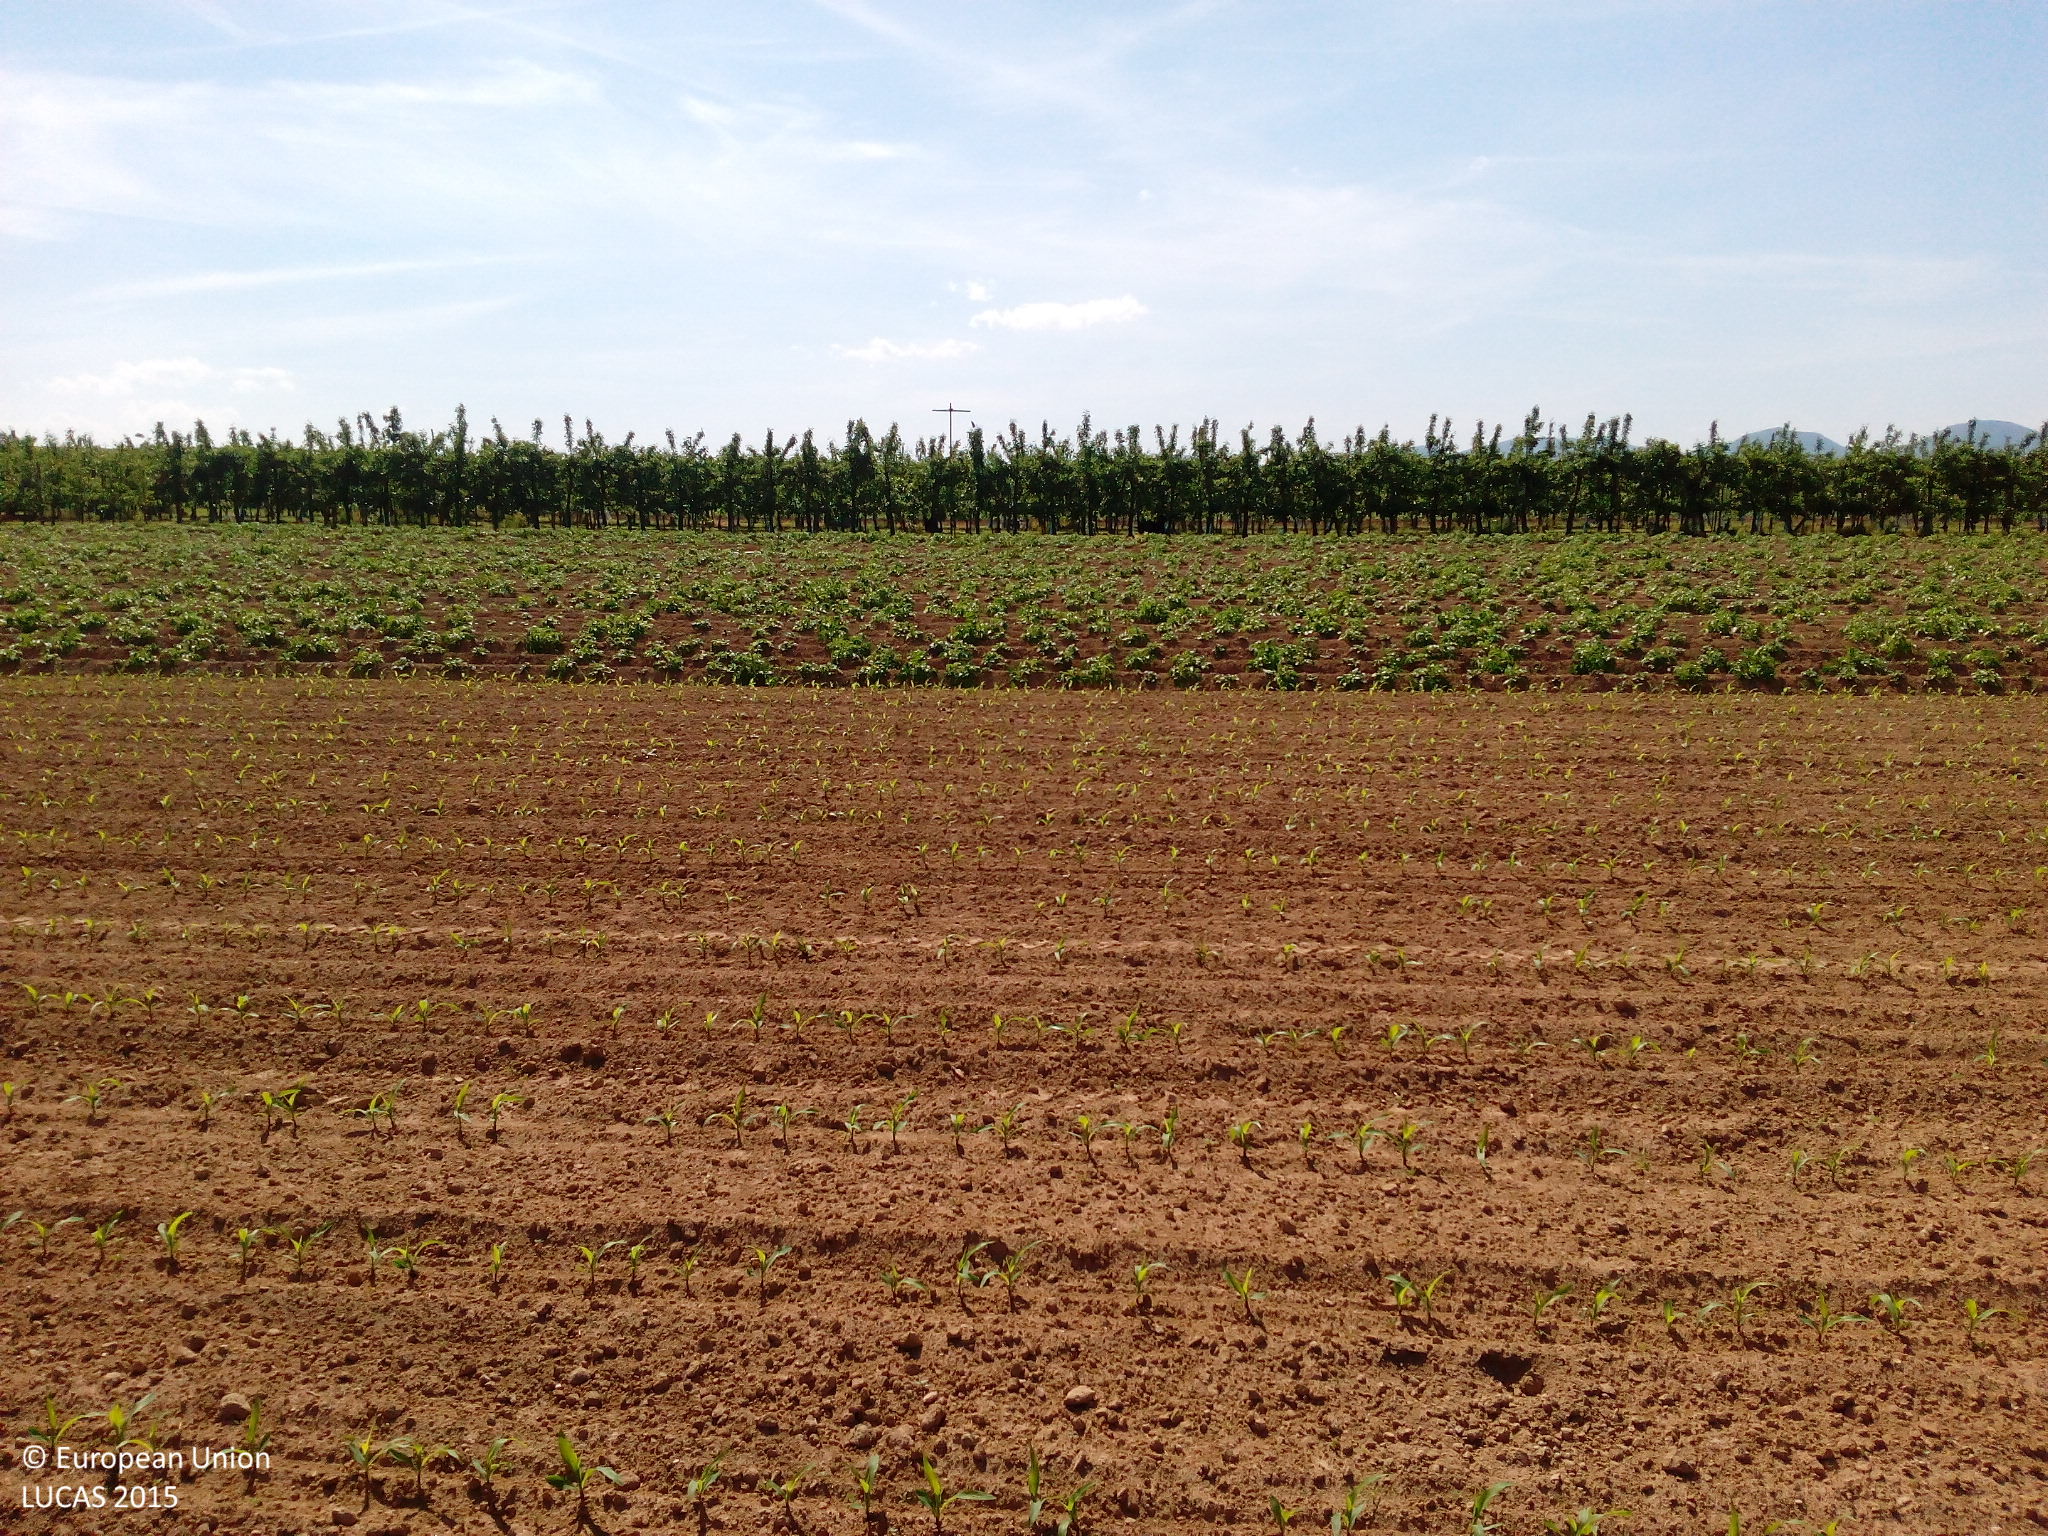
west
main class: Cropland
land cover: Common wheat
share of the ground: > 75 %
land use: Agriculture (excluding fallow land and kitchen gardens)
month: May
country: DE
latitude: 49.1802
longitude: 8.1760
